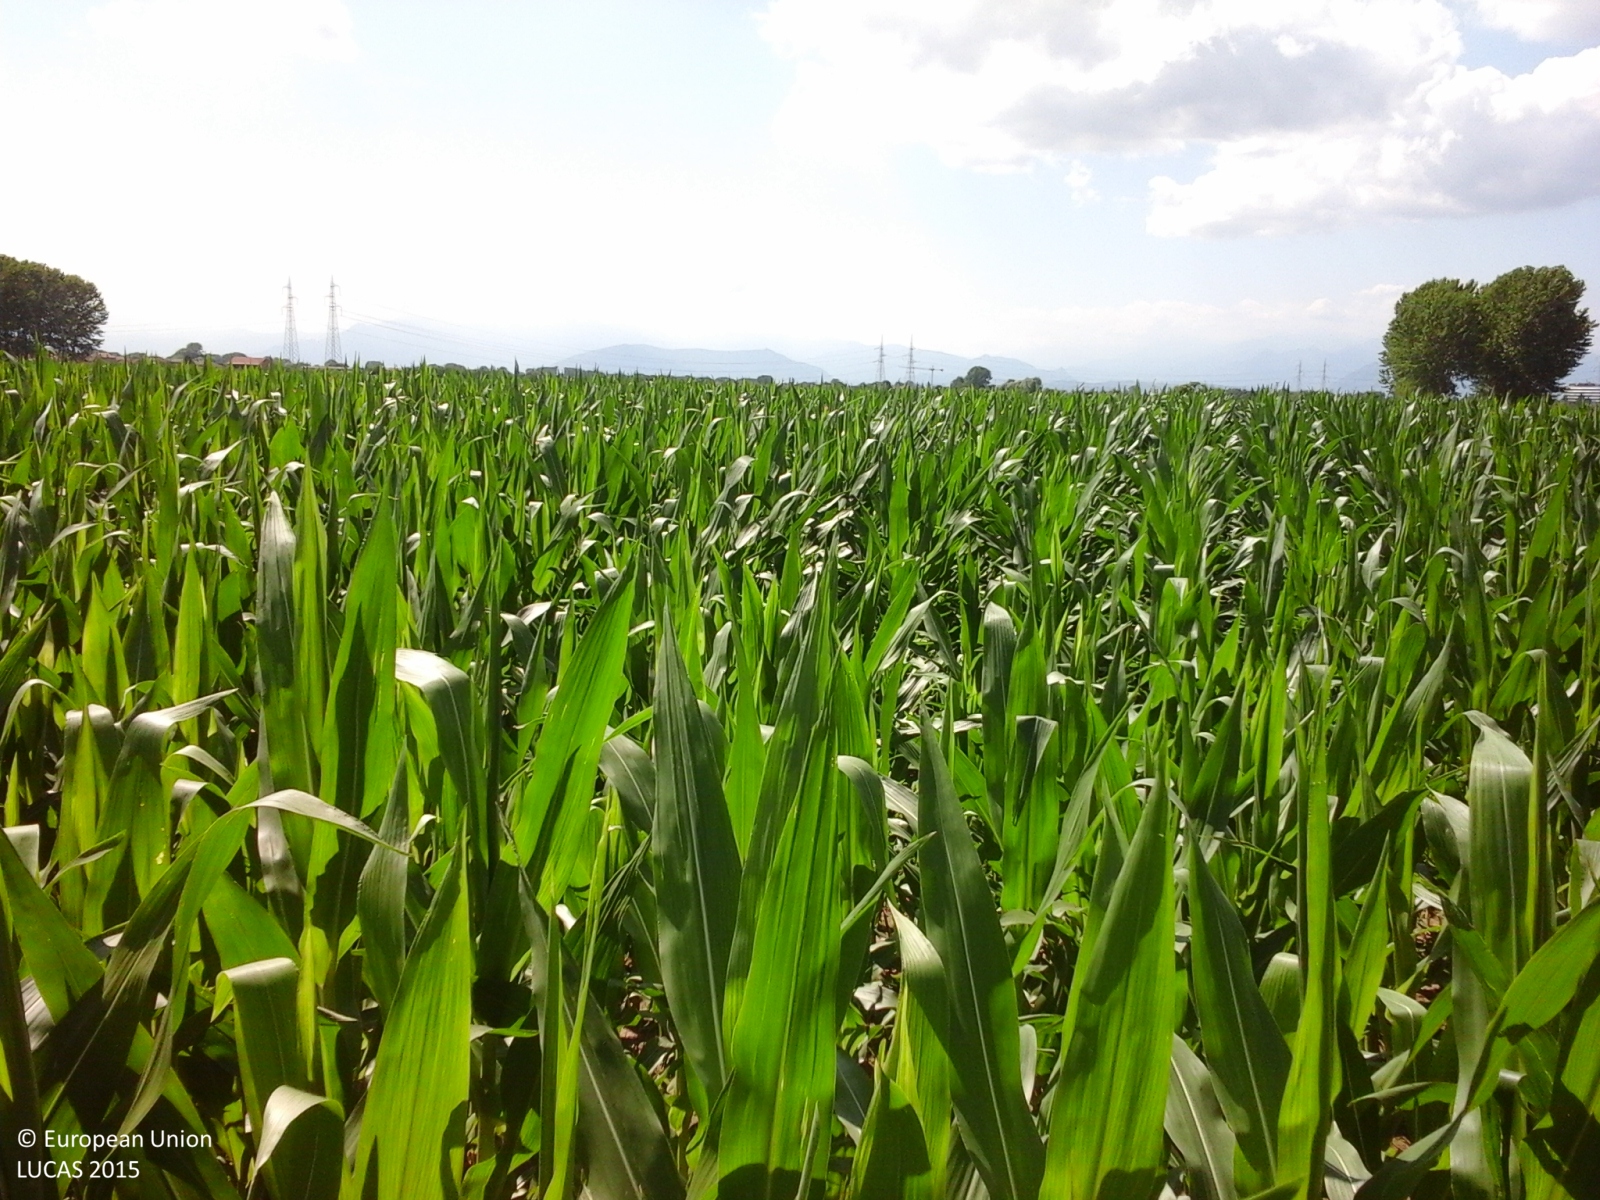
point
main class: Cropland
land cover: Maize
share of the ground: > 75 %
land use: Agriculture (excluding fallow land and kitchen gardens)
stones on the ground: 10 - 25 %
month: June
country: IT
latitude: 44.9572
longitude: 7.7350
